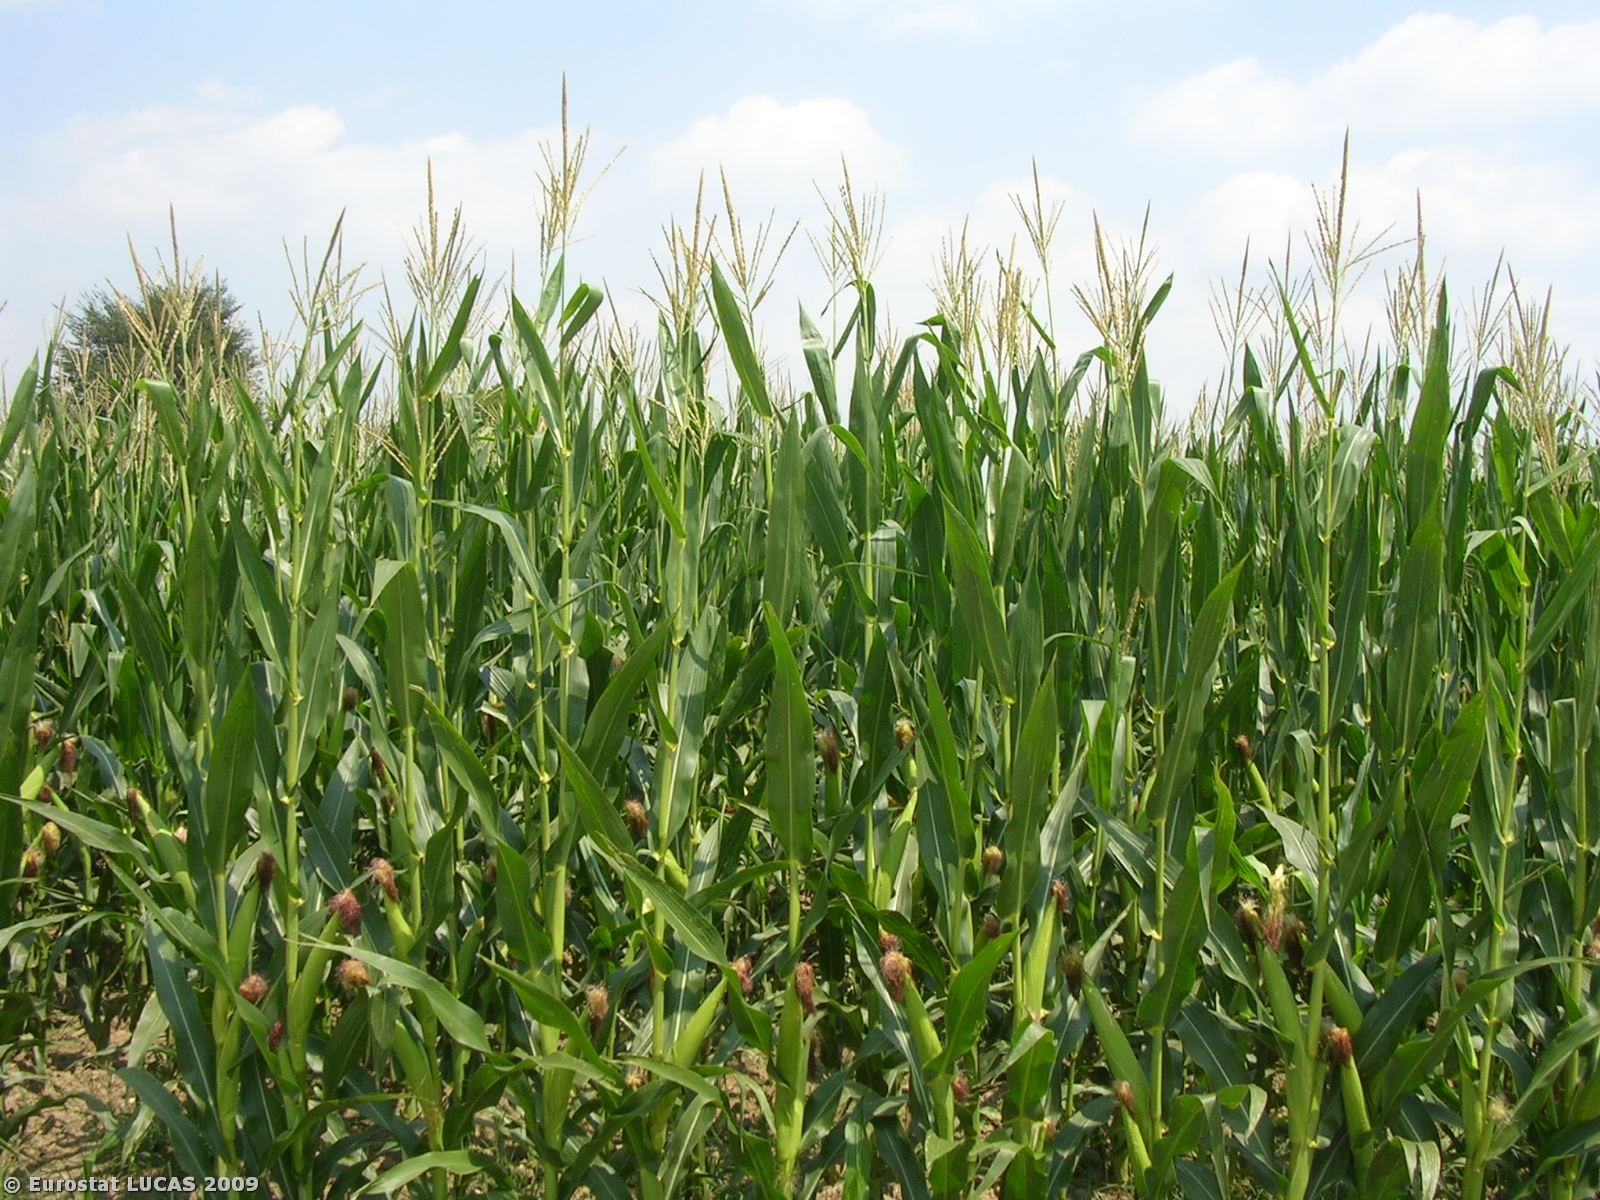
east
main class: Cropland
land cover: Maize
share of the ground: > 75 %
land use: Agriculture (excluding fallow land and kitchen gardens)
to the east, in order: Maize; Grass margins; Tracks; Grass margins; Maize; Grass margins; Fences; Grassland without tree/shrub cover; Electric lines; Grassland without tree/shrub cover; Fences; Tracks; Grass margins; Maize; Ditches and canals; Grass margins
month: July
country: IT
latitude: 45.4539
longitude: 11.7490
